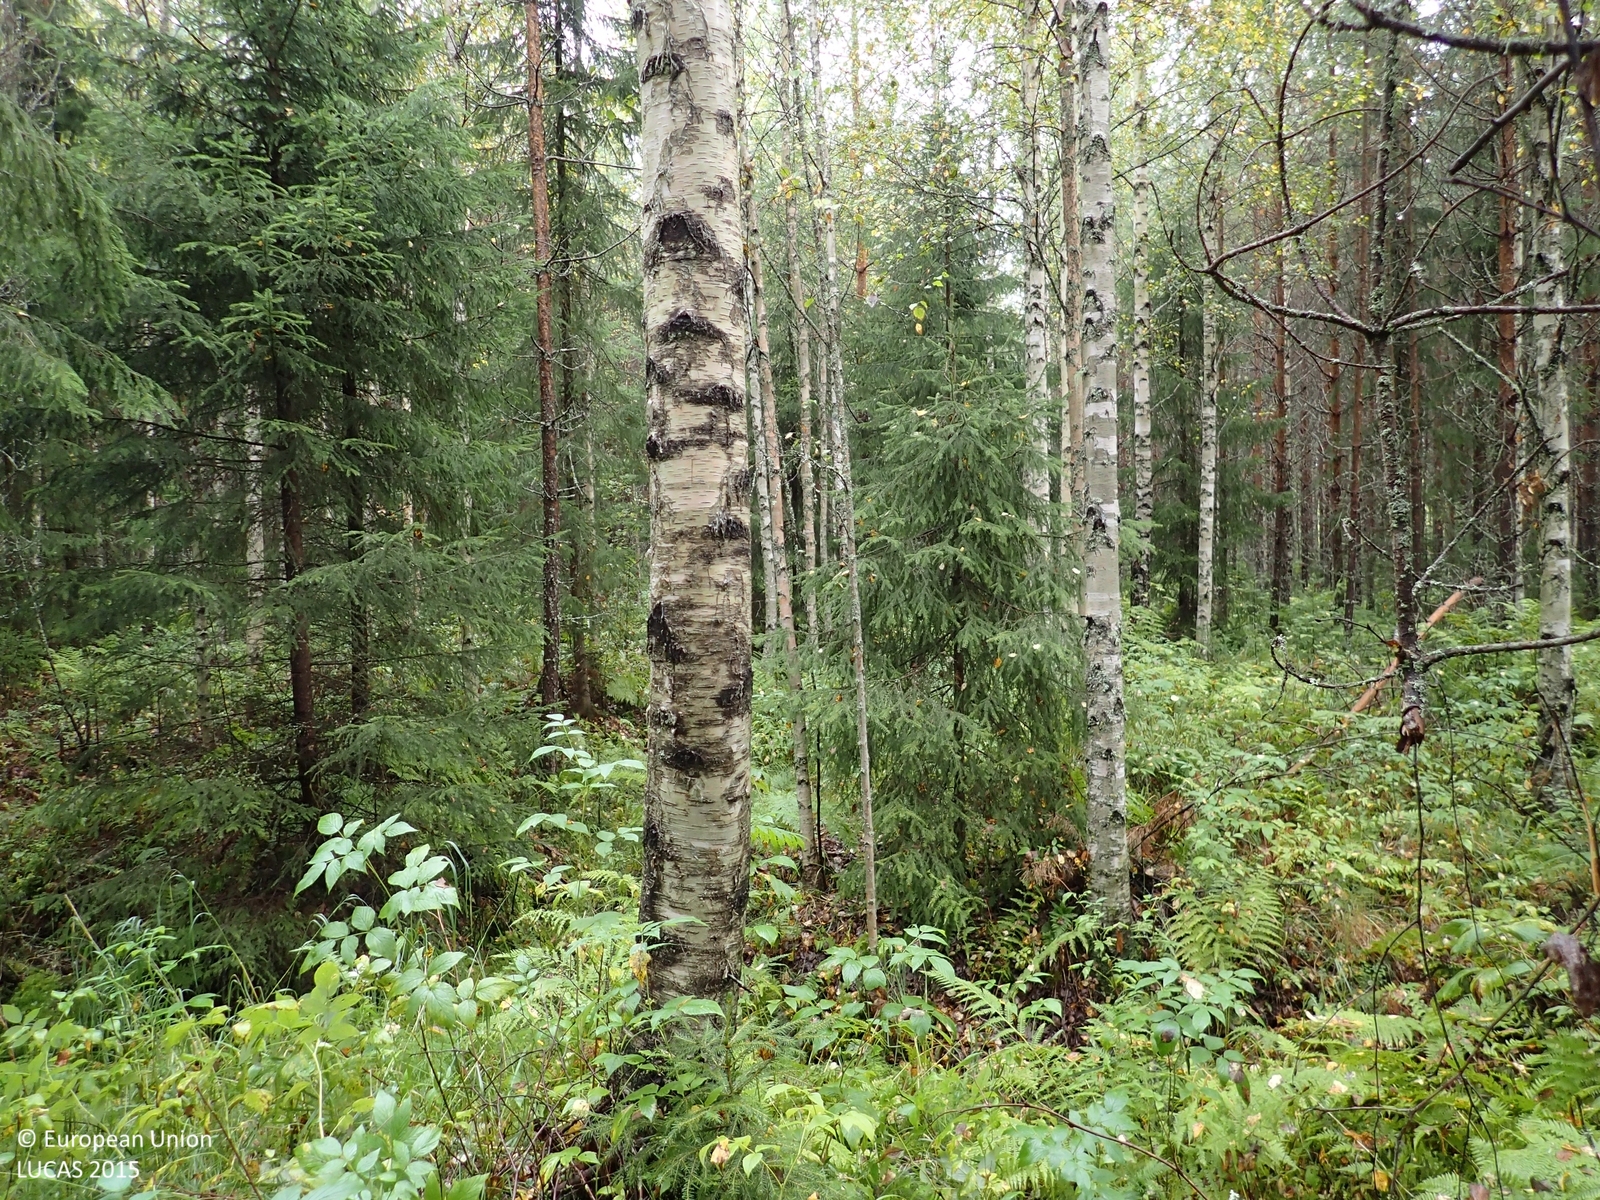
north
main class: Woodland
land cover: Other mixed woodland
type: boreal forest
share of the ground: > 75 %
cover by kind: coniferous forest trees 55 %, broadleaved forest trees 20 %, herbaceous plants 20 %, lichens and mosses 5 %
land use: Forestry
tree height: > 5 m
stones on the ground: < 10 %
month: September
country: FI
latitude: 63.1190
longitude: 25.7936
